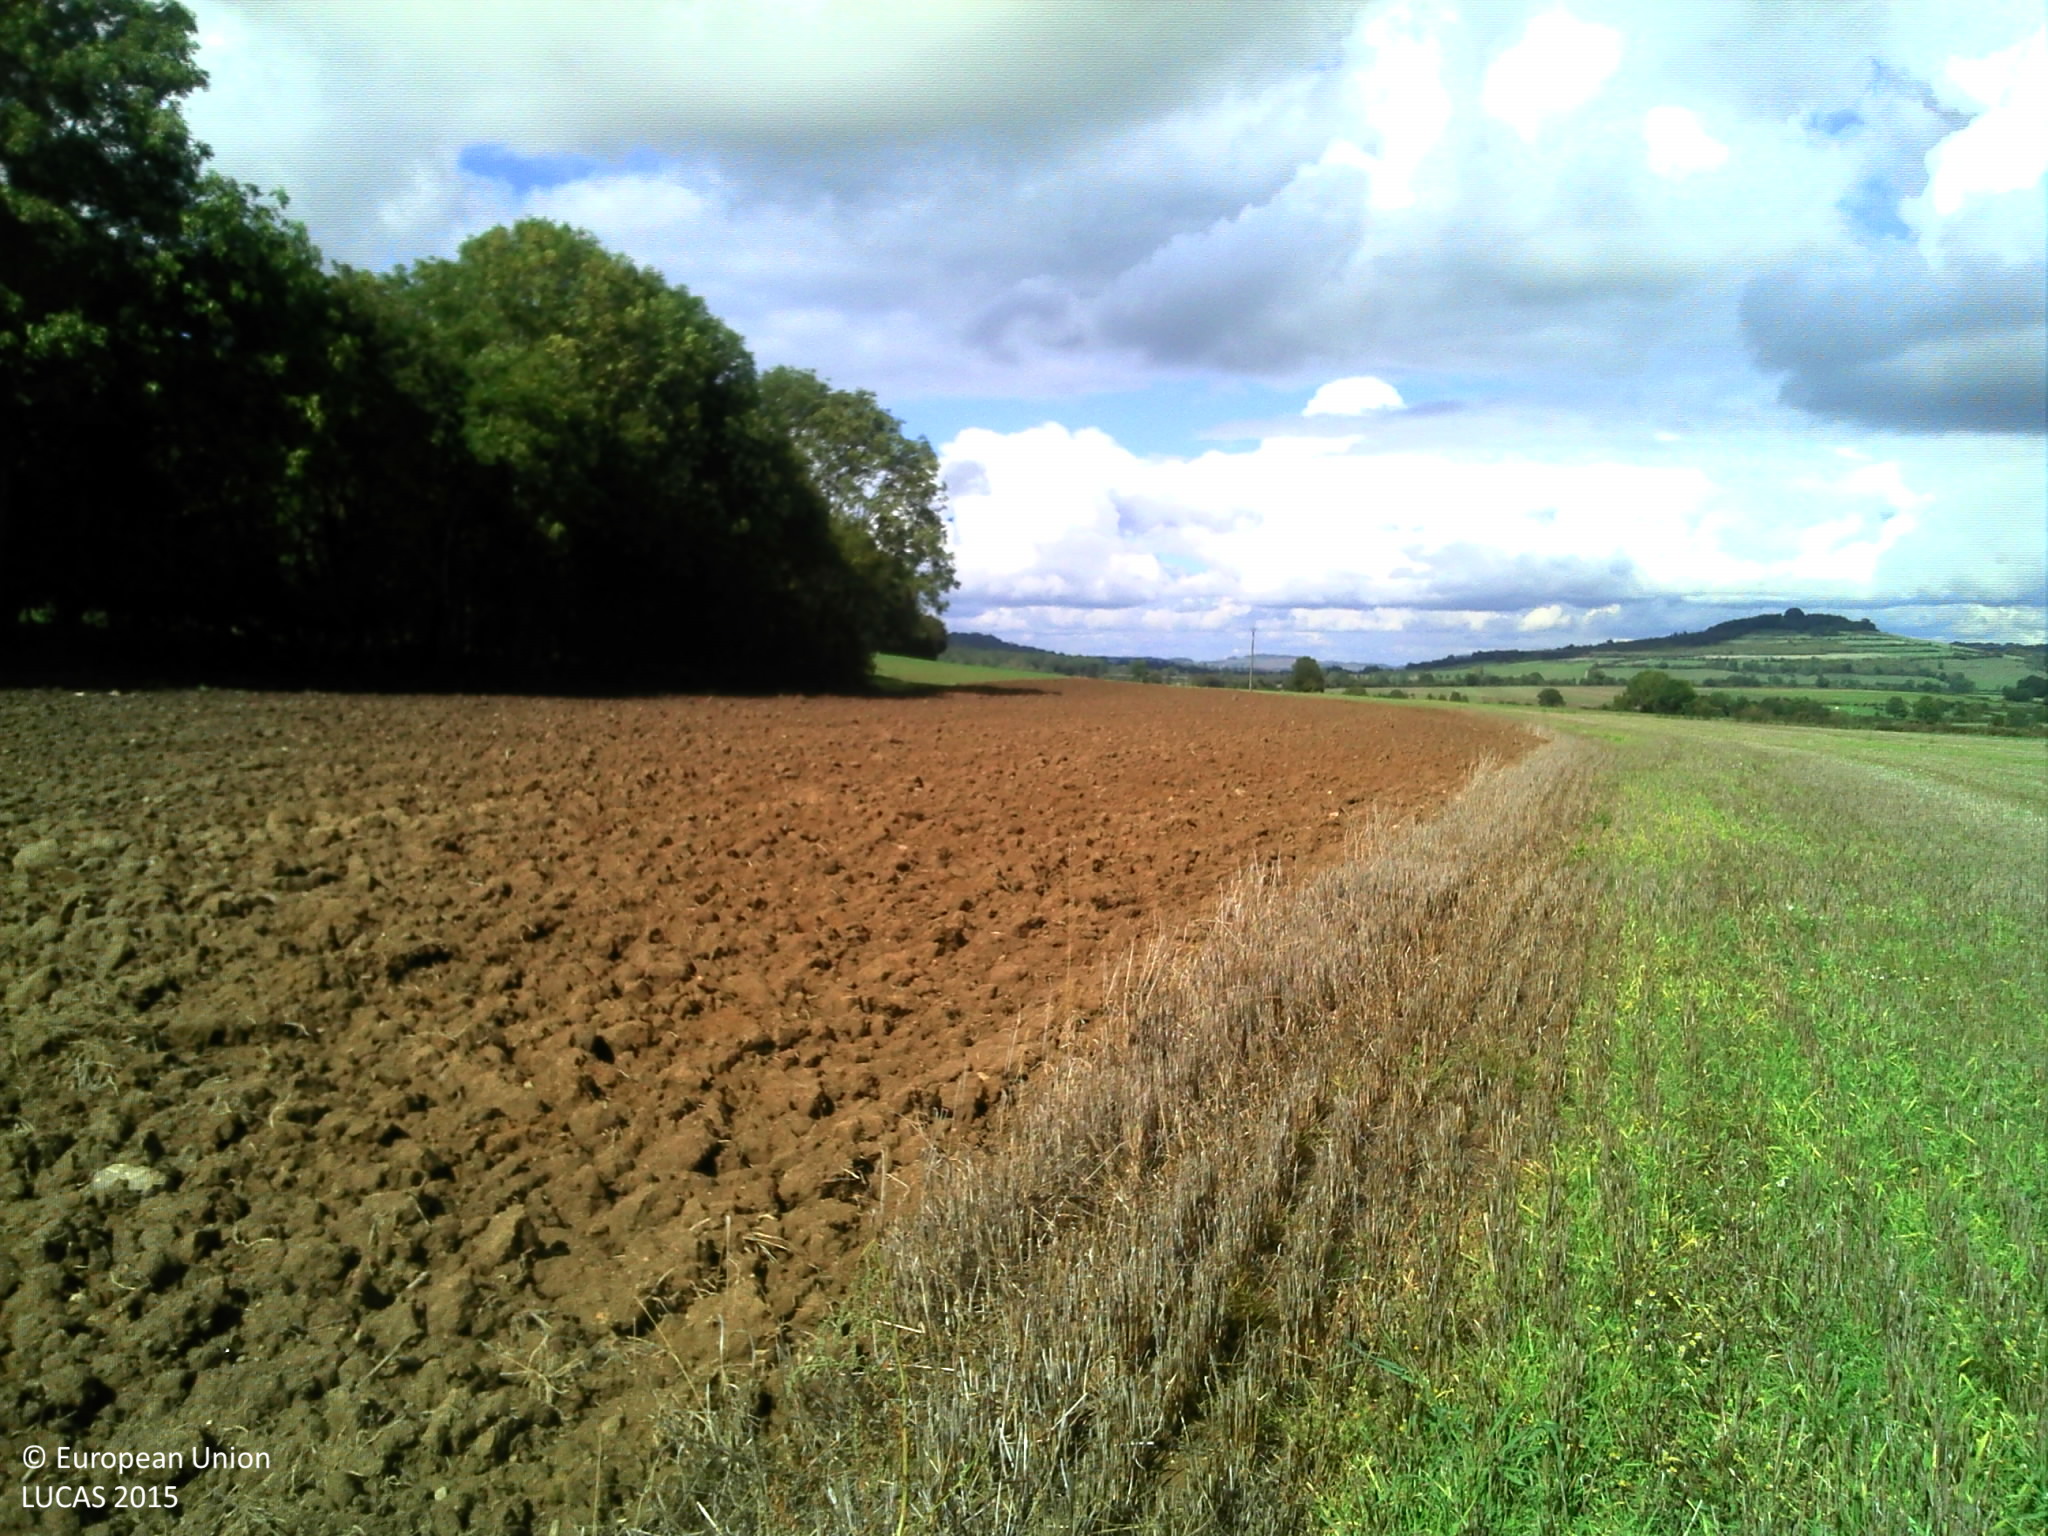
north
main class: Grassland
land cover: Spontaneously vegetated surfaces
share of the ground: > 75 %
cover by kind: herbaceous plants 100 %
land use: Agriculture (excluding fallow land and kitchen gardens)
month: September
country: FR
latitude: 47.1940
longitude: 4.3371
